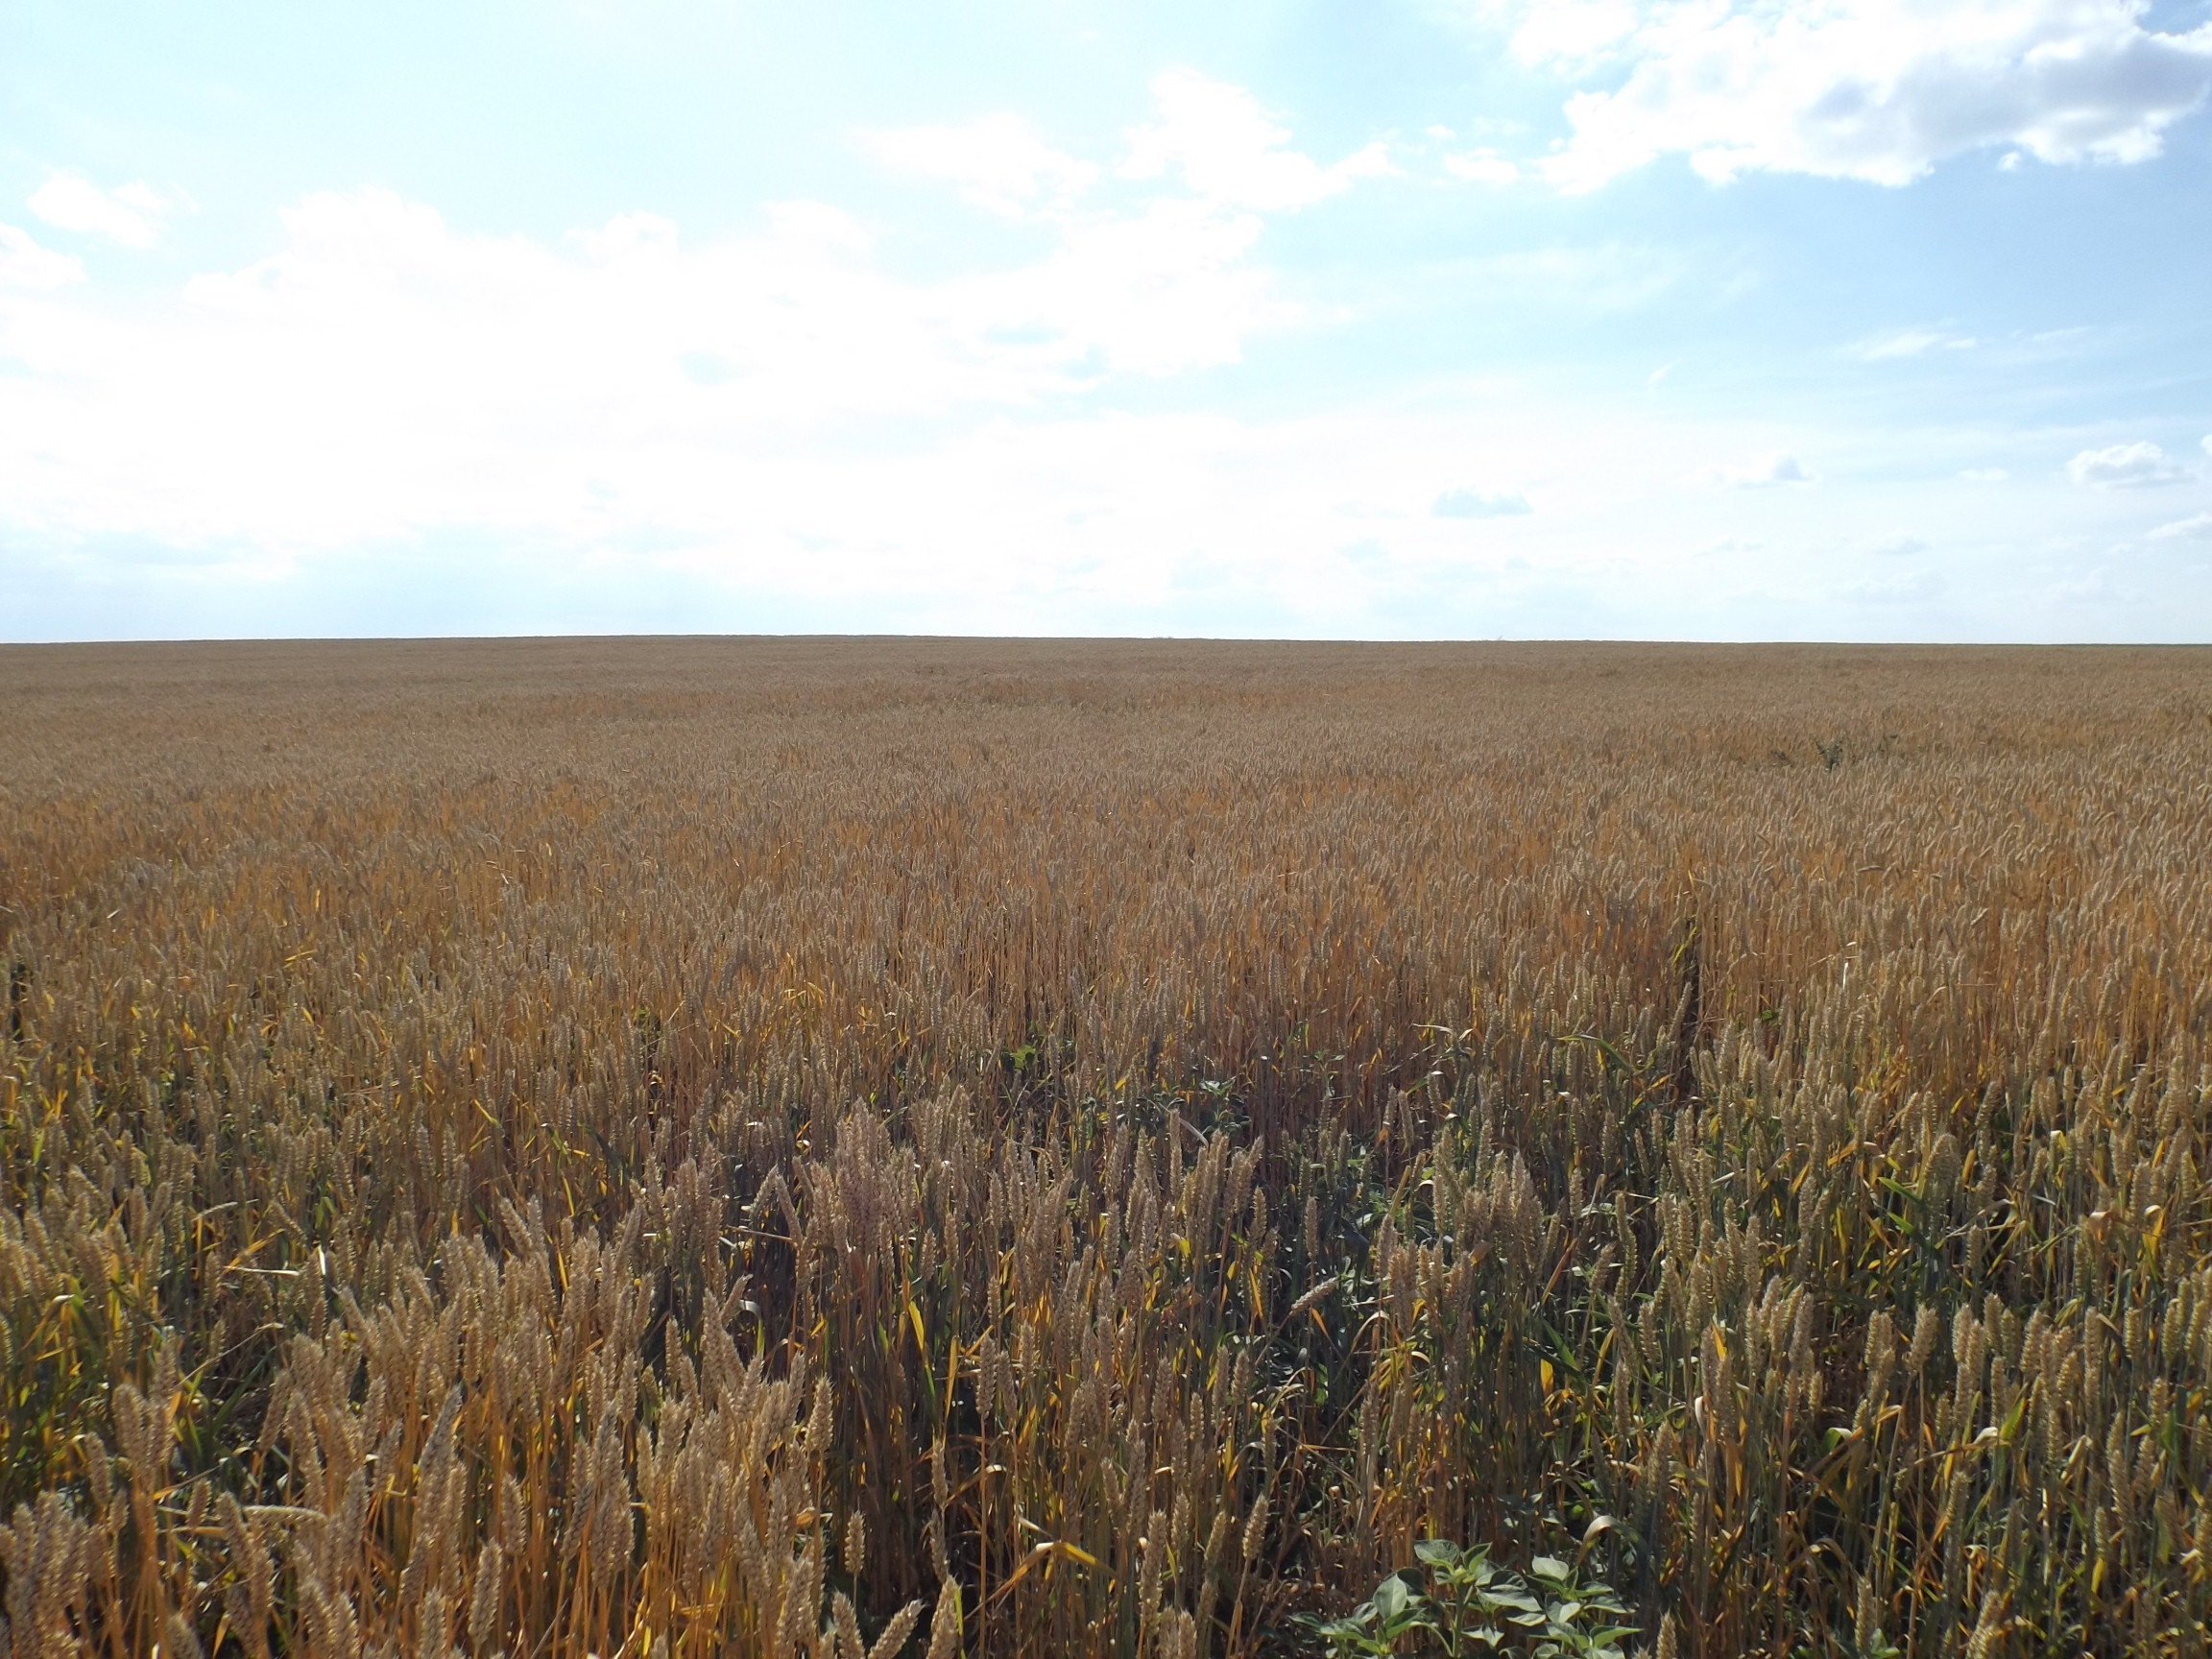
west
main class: Cropland
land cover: Common wheat
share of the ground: > 75 %
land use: Agriculture (excluding fallow land and kitchen gardens)
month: June
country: BG
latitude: 43.4637
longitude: 27.6745
